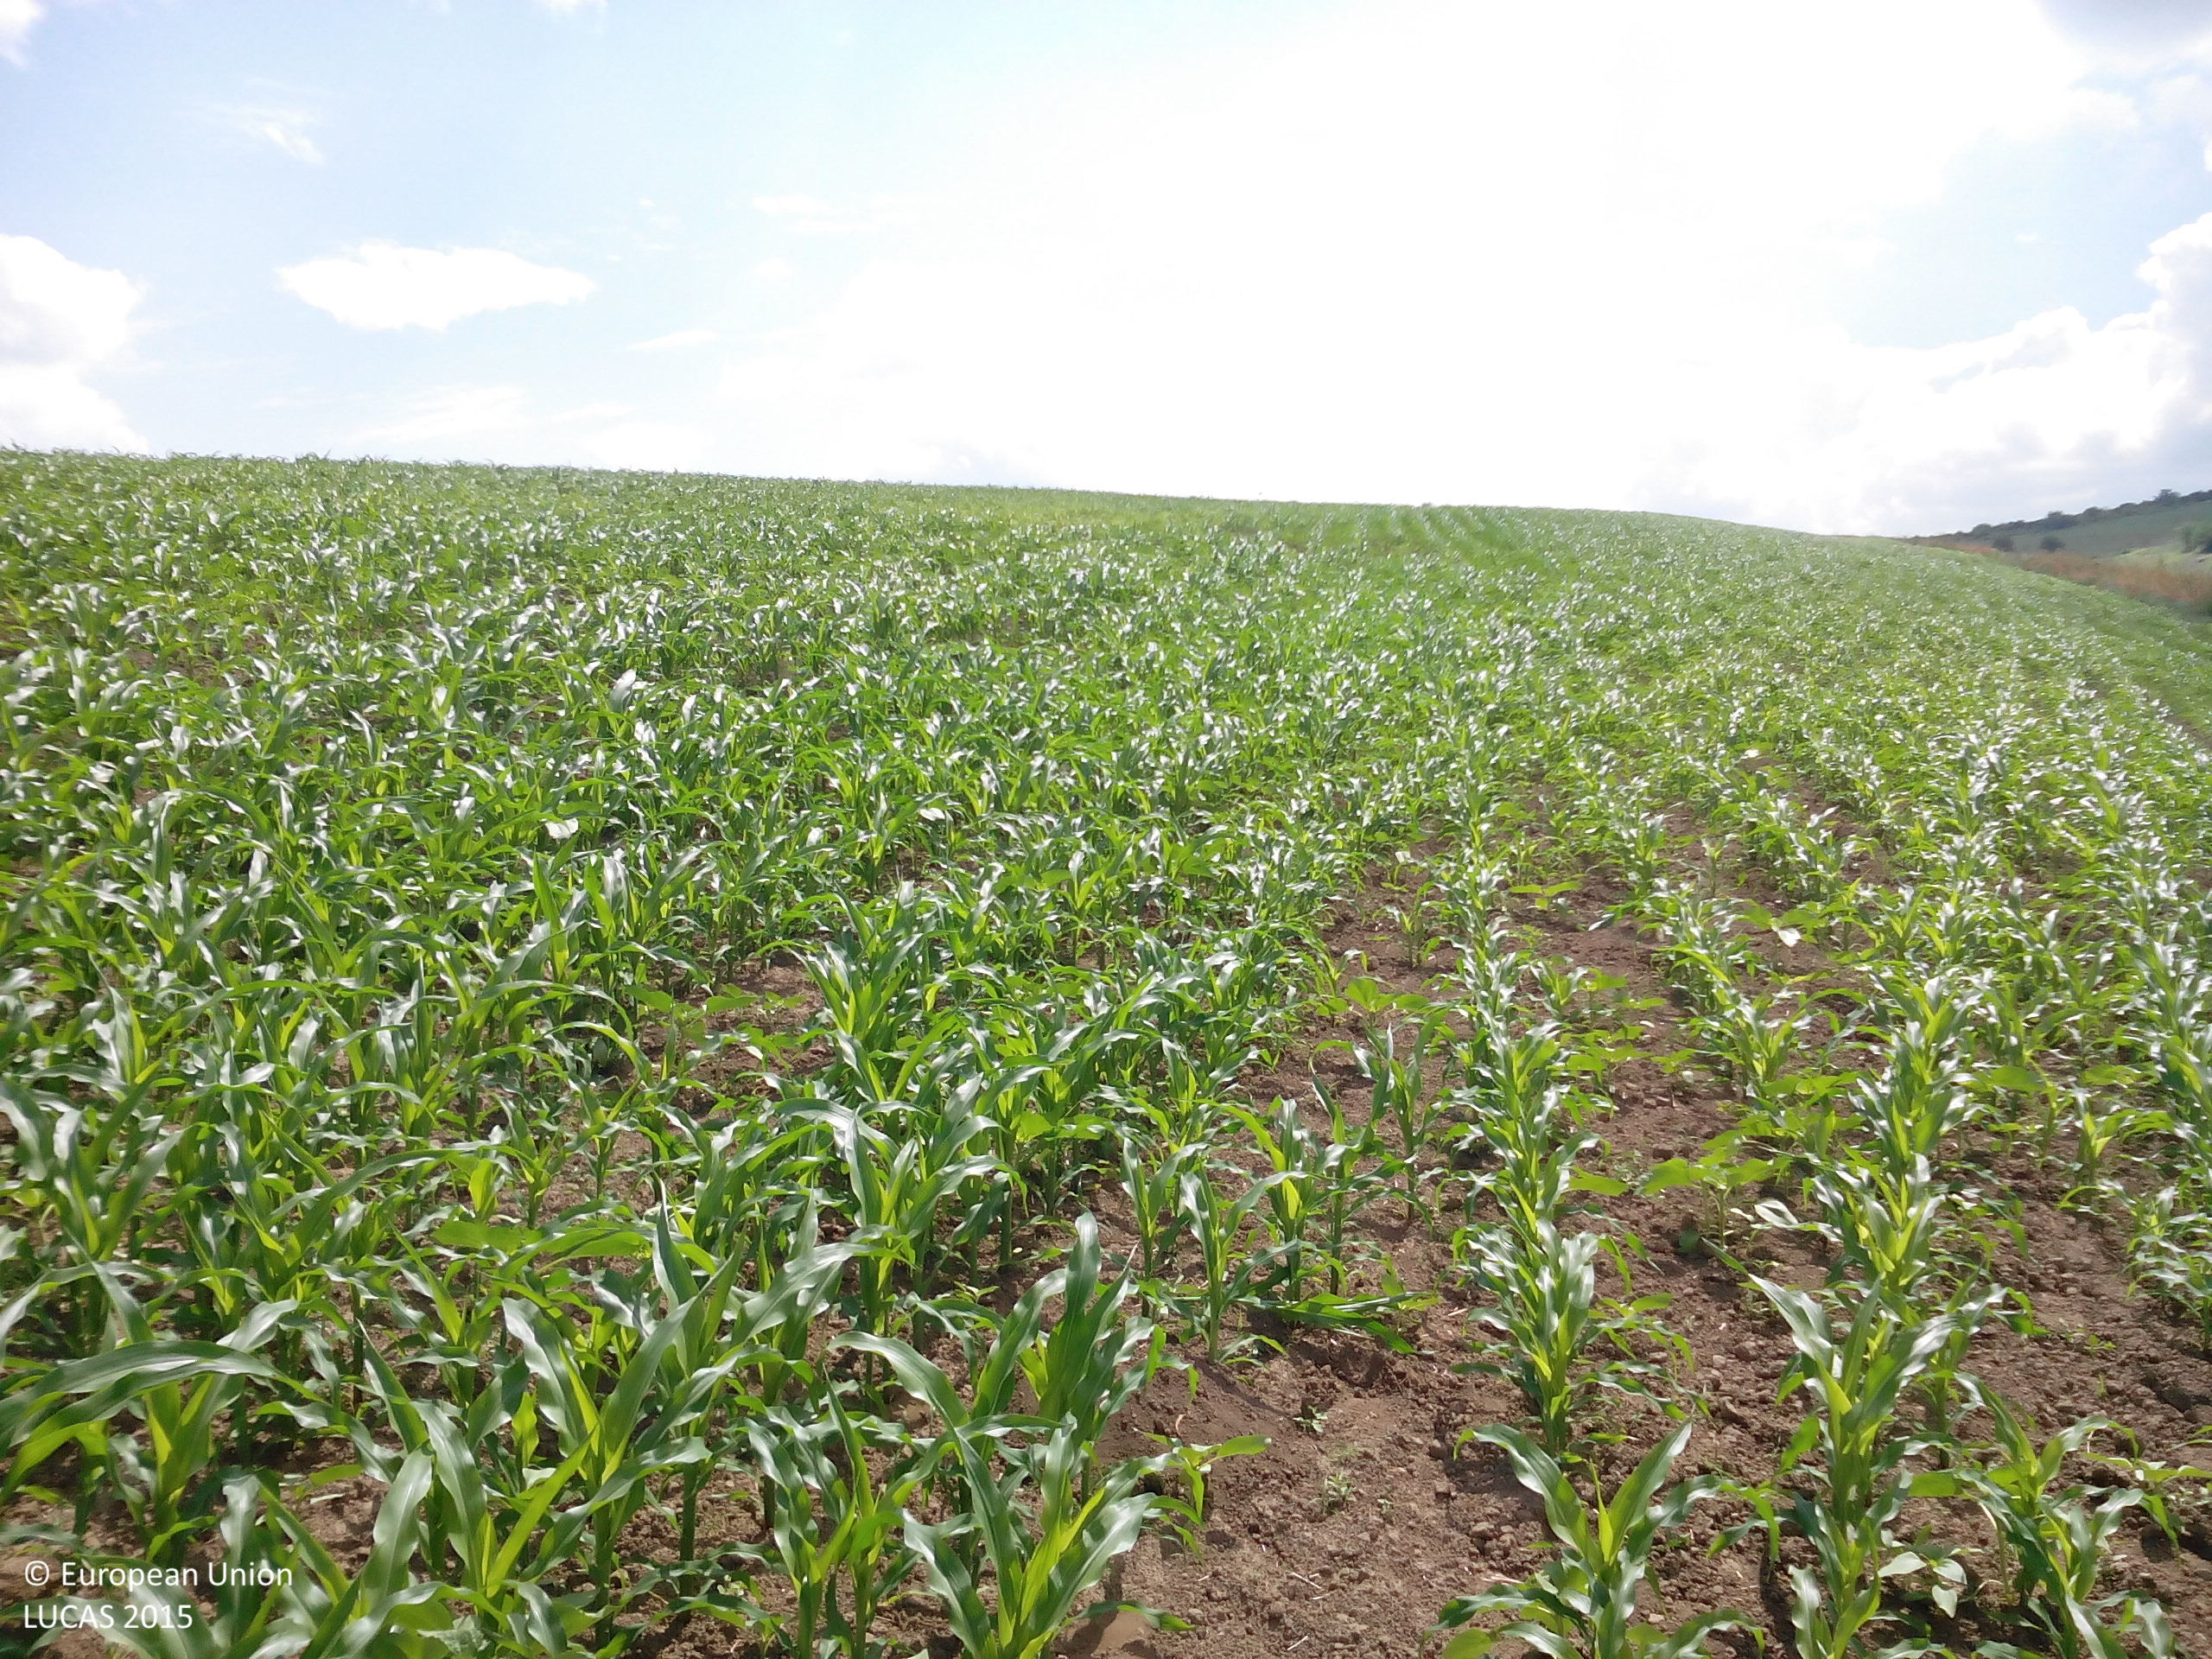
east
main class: Cropland
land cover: Maize
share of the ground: 25 - 50 %
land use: Agriculture (excluding fallow land and kitchen gardens)
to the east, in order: Maize; Grassland without tree/shrub cover
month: May
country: BG
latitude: 43.6851
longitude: 24.2886
